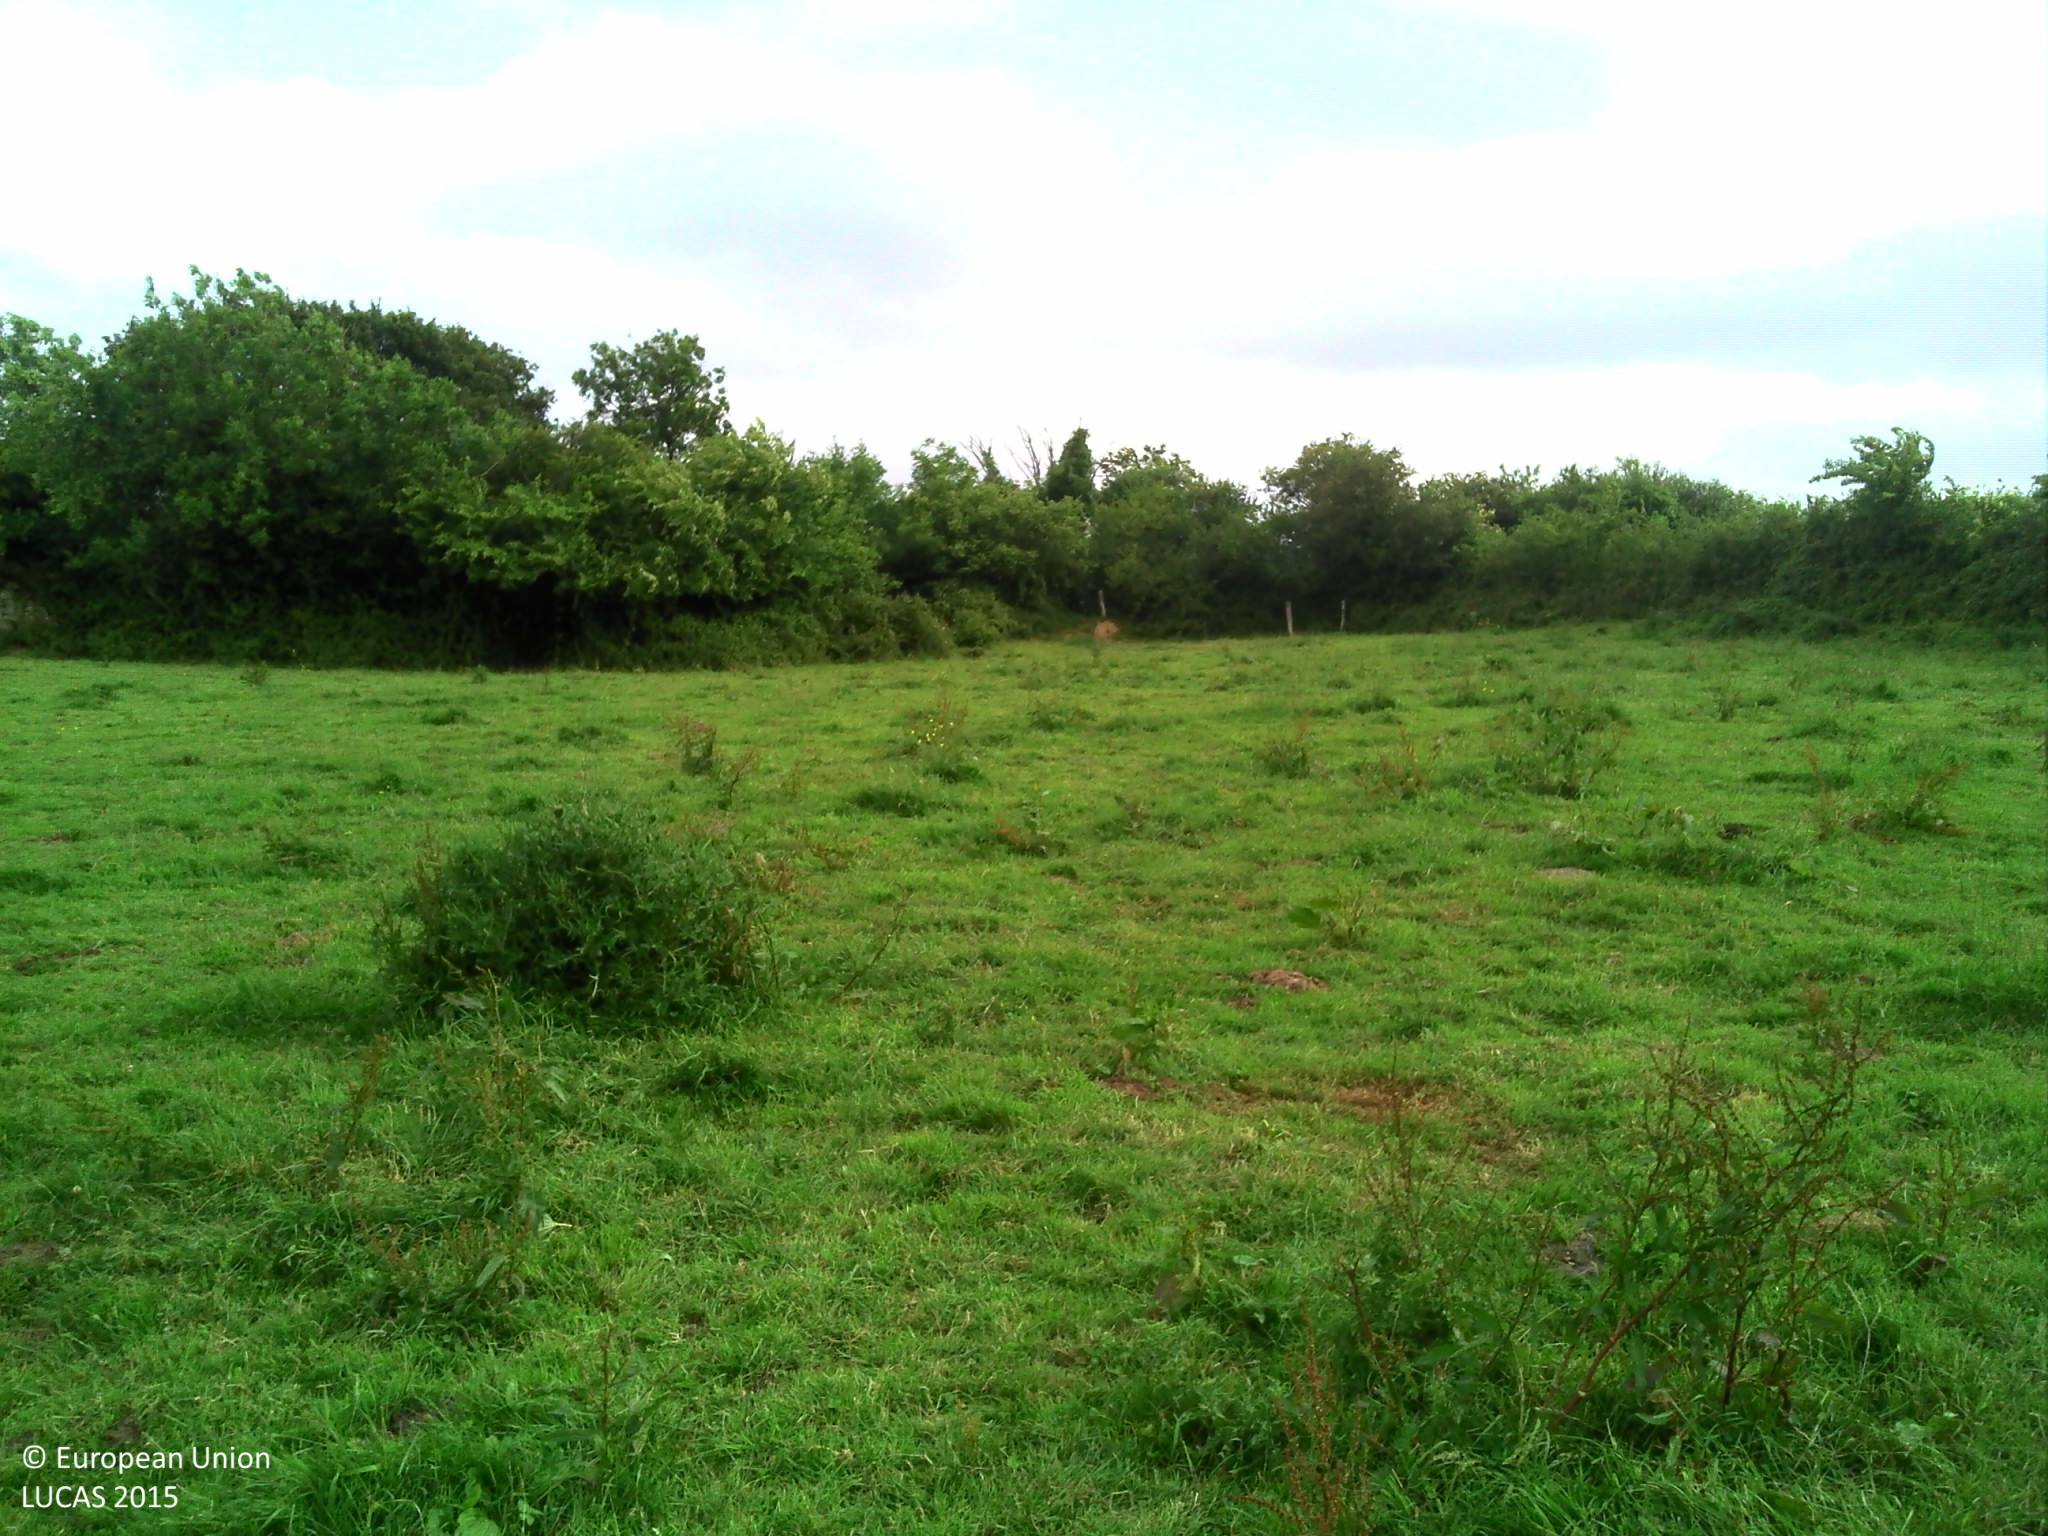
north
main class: Grassland
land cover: Grassland without tree/shrub cover
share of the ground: > 75 %
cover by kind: herbaceous plants 95 %, shrubs 5 %
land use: Agriculture (excluding fallow land and kitchen gardens)
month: June
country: FR
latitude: 49.5356
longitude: -1.4207
